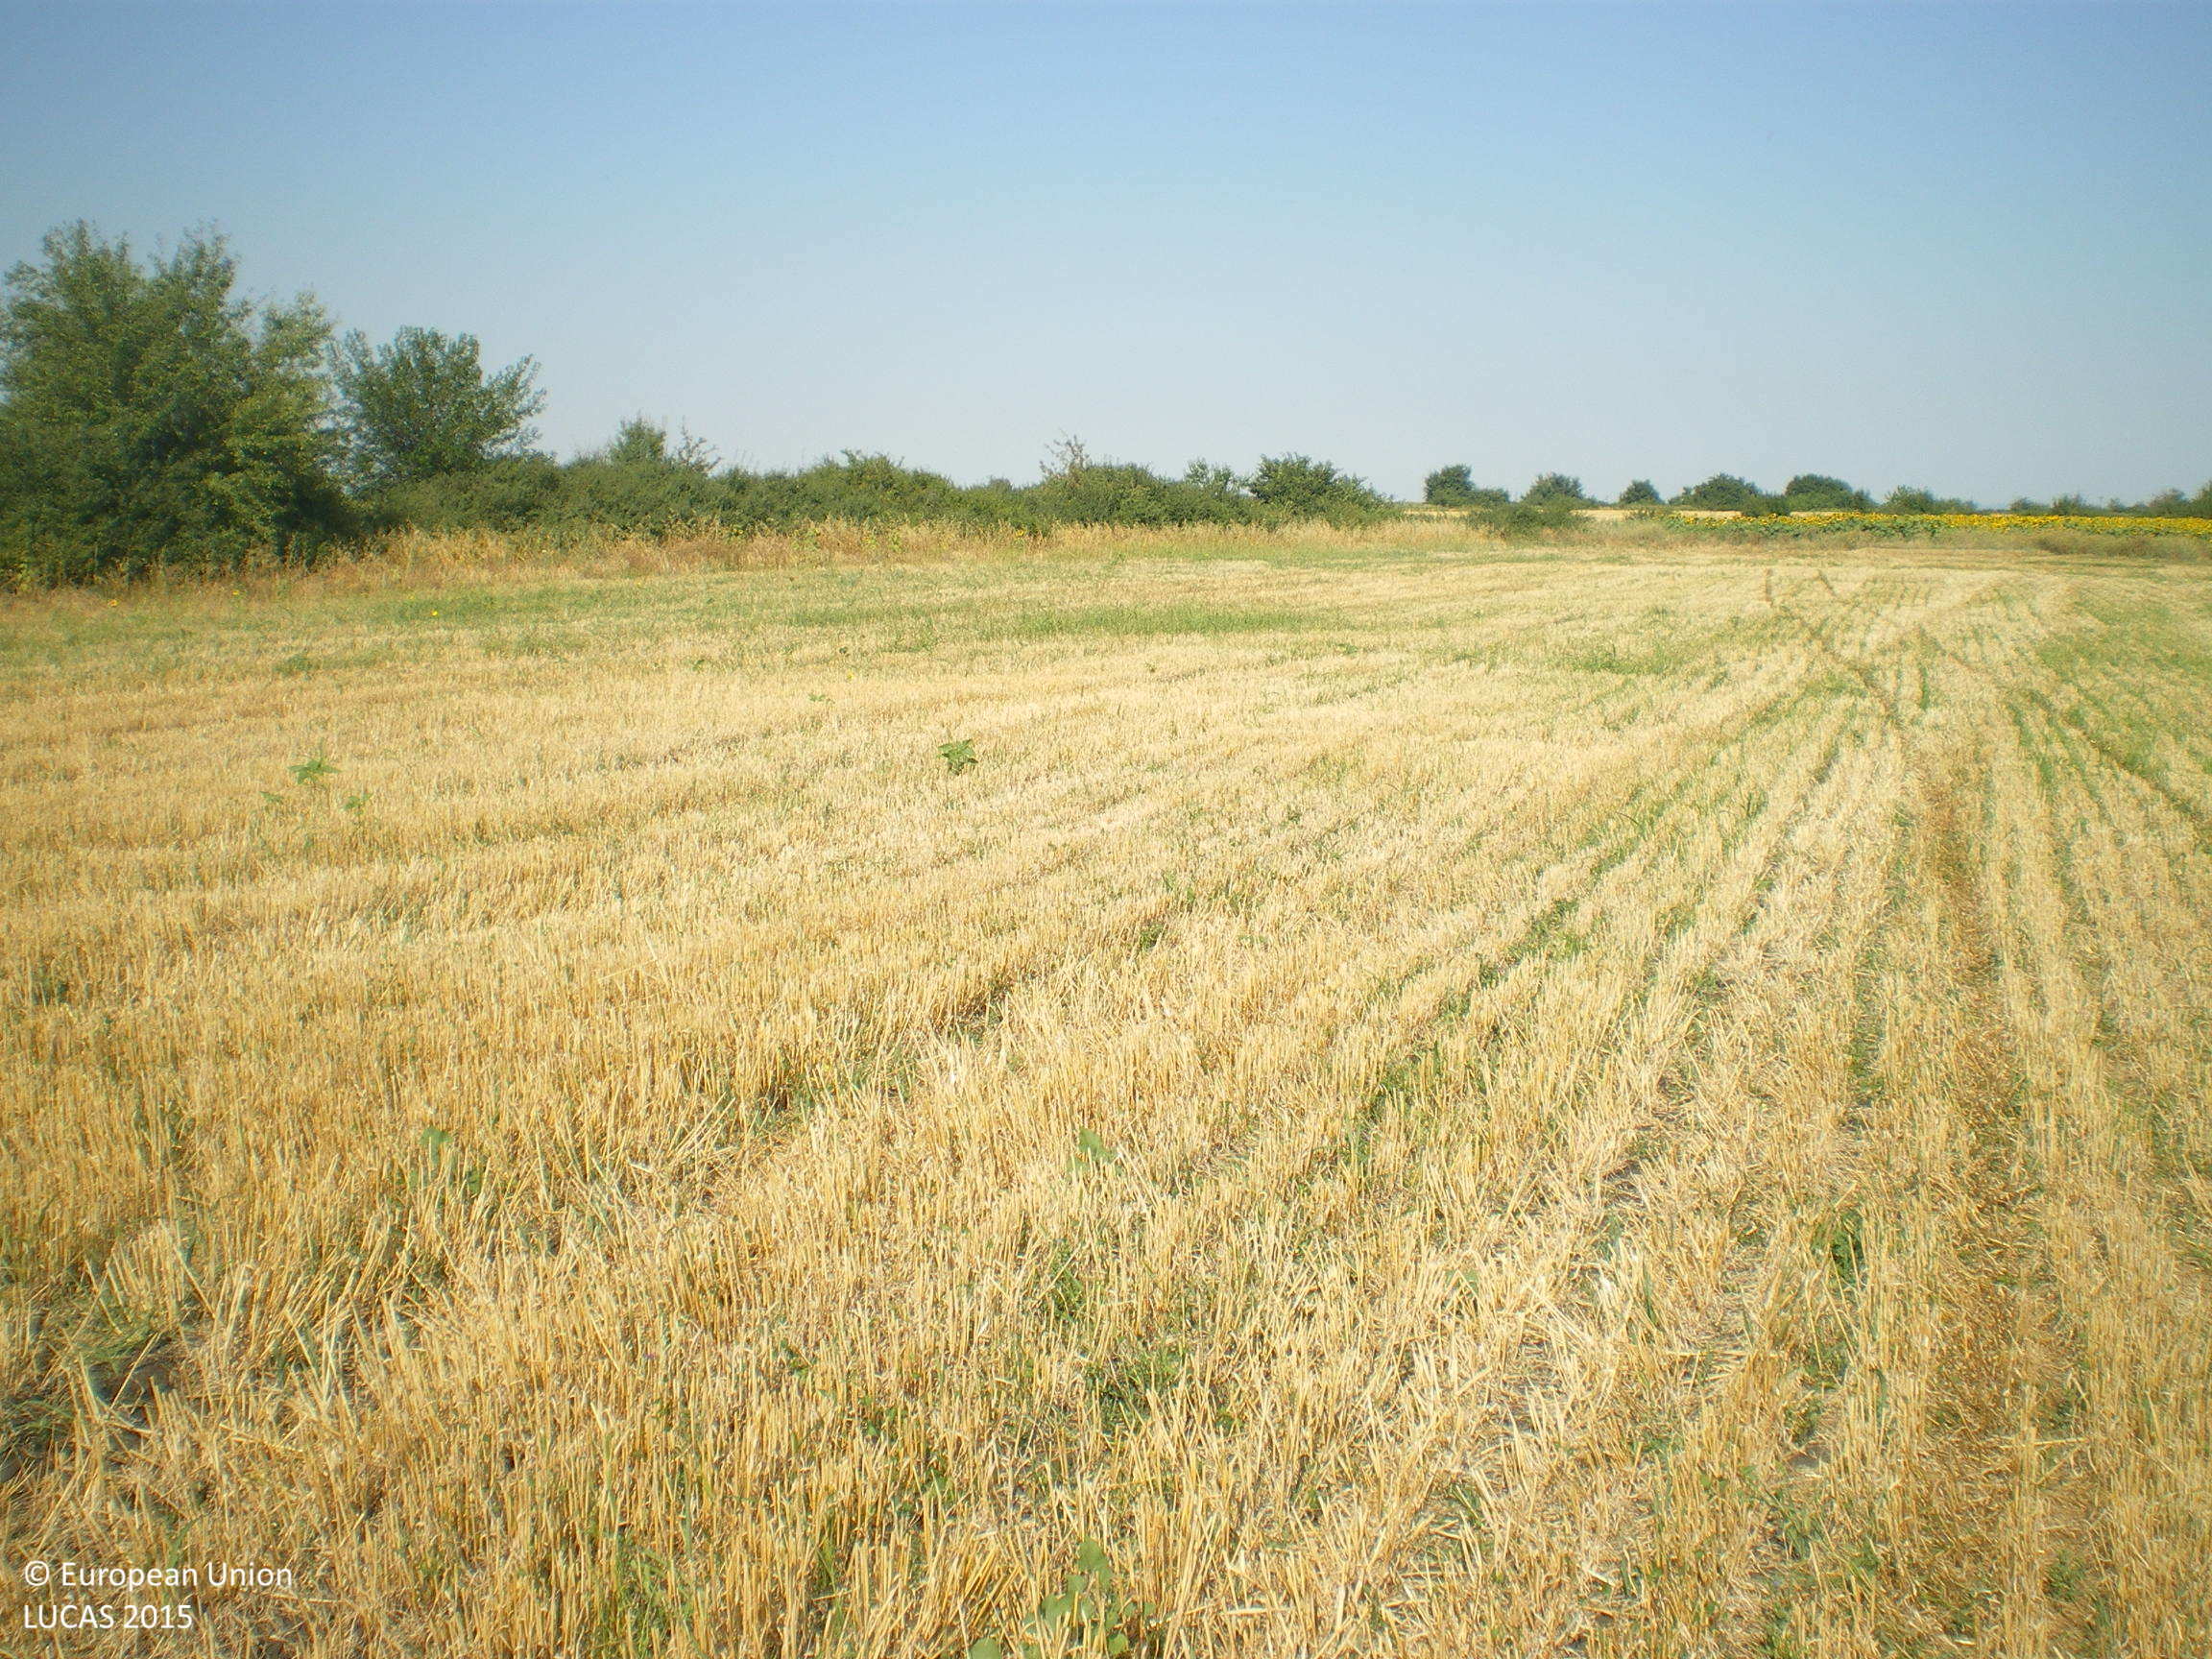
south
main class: Cropland
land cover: Common wheat
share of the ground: 10 - 25 %
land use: Agriculture (excluding fallow land and kitchen gardens)
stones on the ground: < 10 %
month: July
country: BG
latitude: 42.2305
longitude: 25.6891
